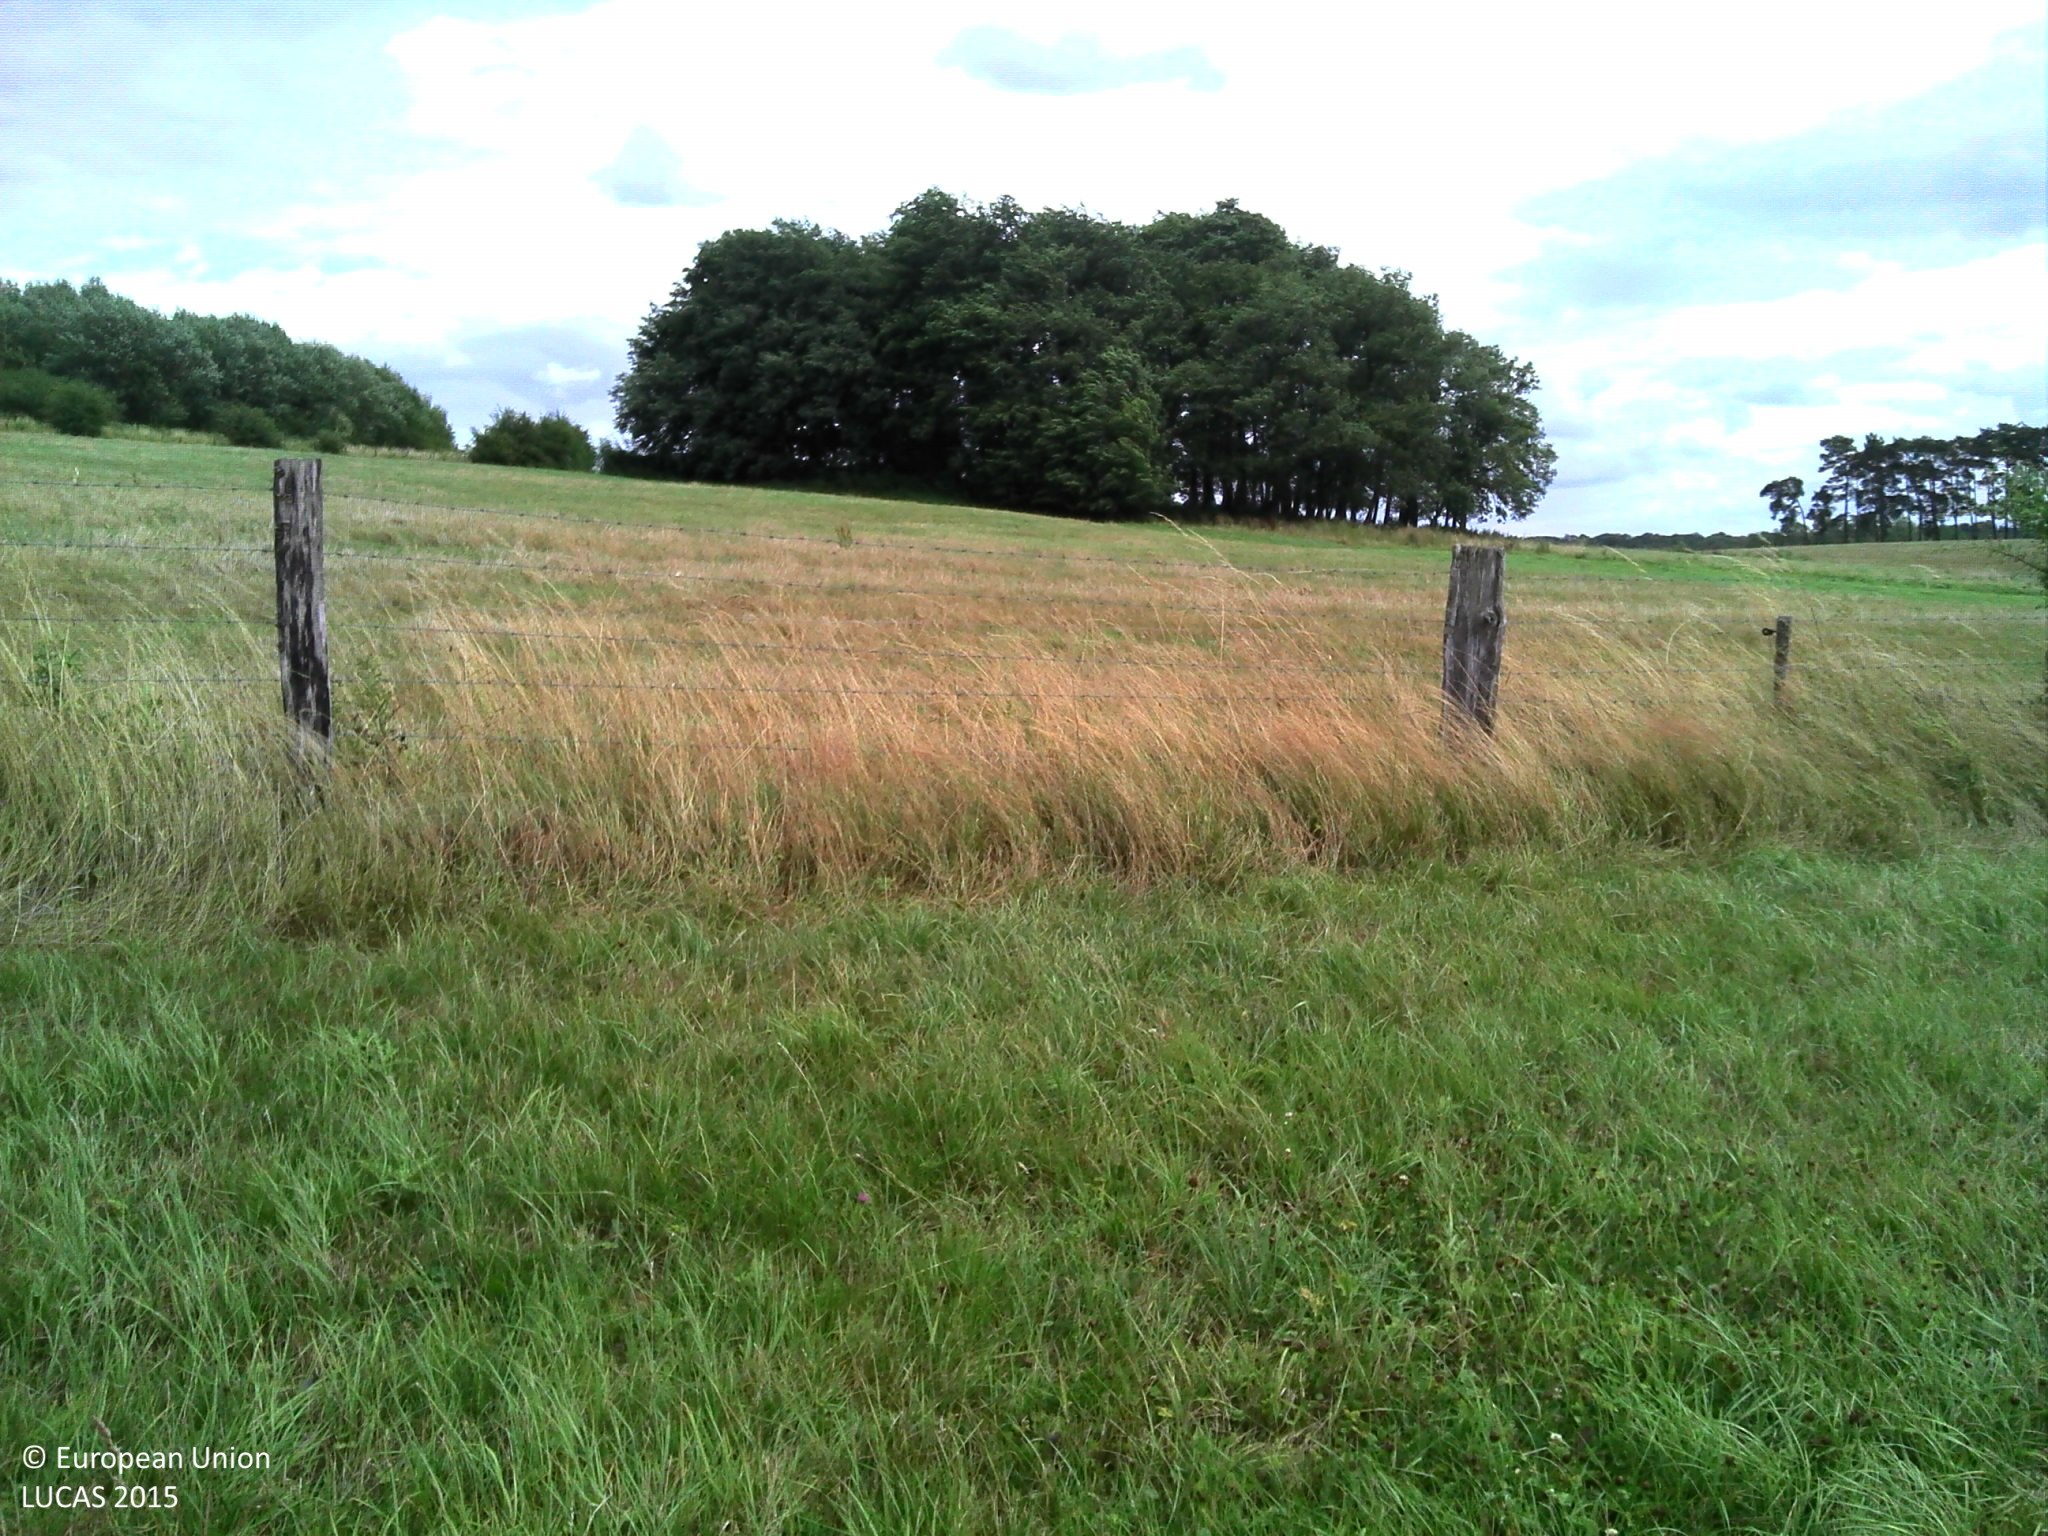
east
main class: Grassland
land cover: Grassland without tree/shrub cover
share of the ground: > 75 %
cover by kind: herbaceous plants 100 %
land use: Agriculture (excluding fallow land and kitchen gardens)
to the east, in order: Grassland without tree/shrub cover; Fences; Grass margins; Fences; Grassland without tree/shrub cover; Fences; Broadleaved woodland; Grassland without tree/shrub cover
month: July
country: BE
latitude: 49.5977
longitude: 5.6682
